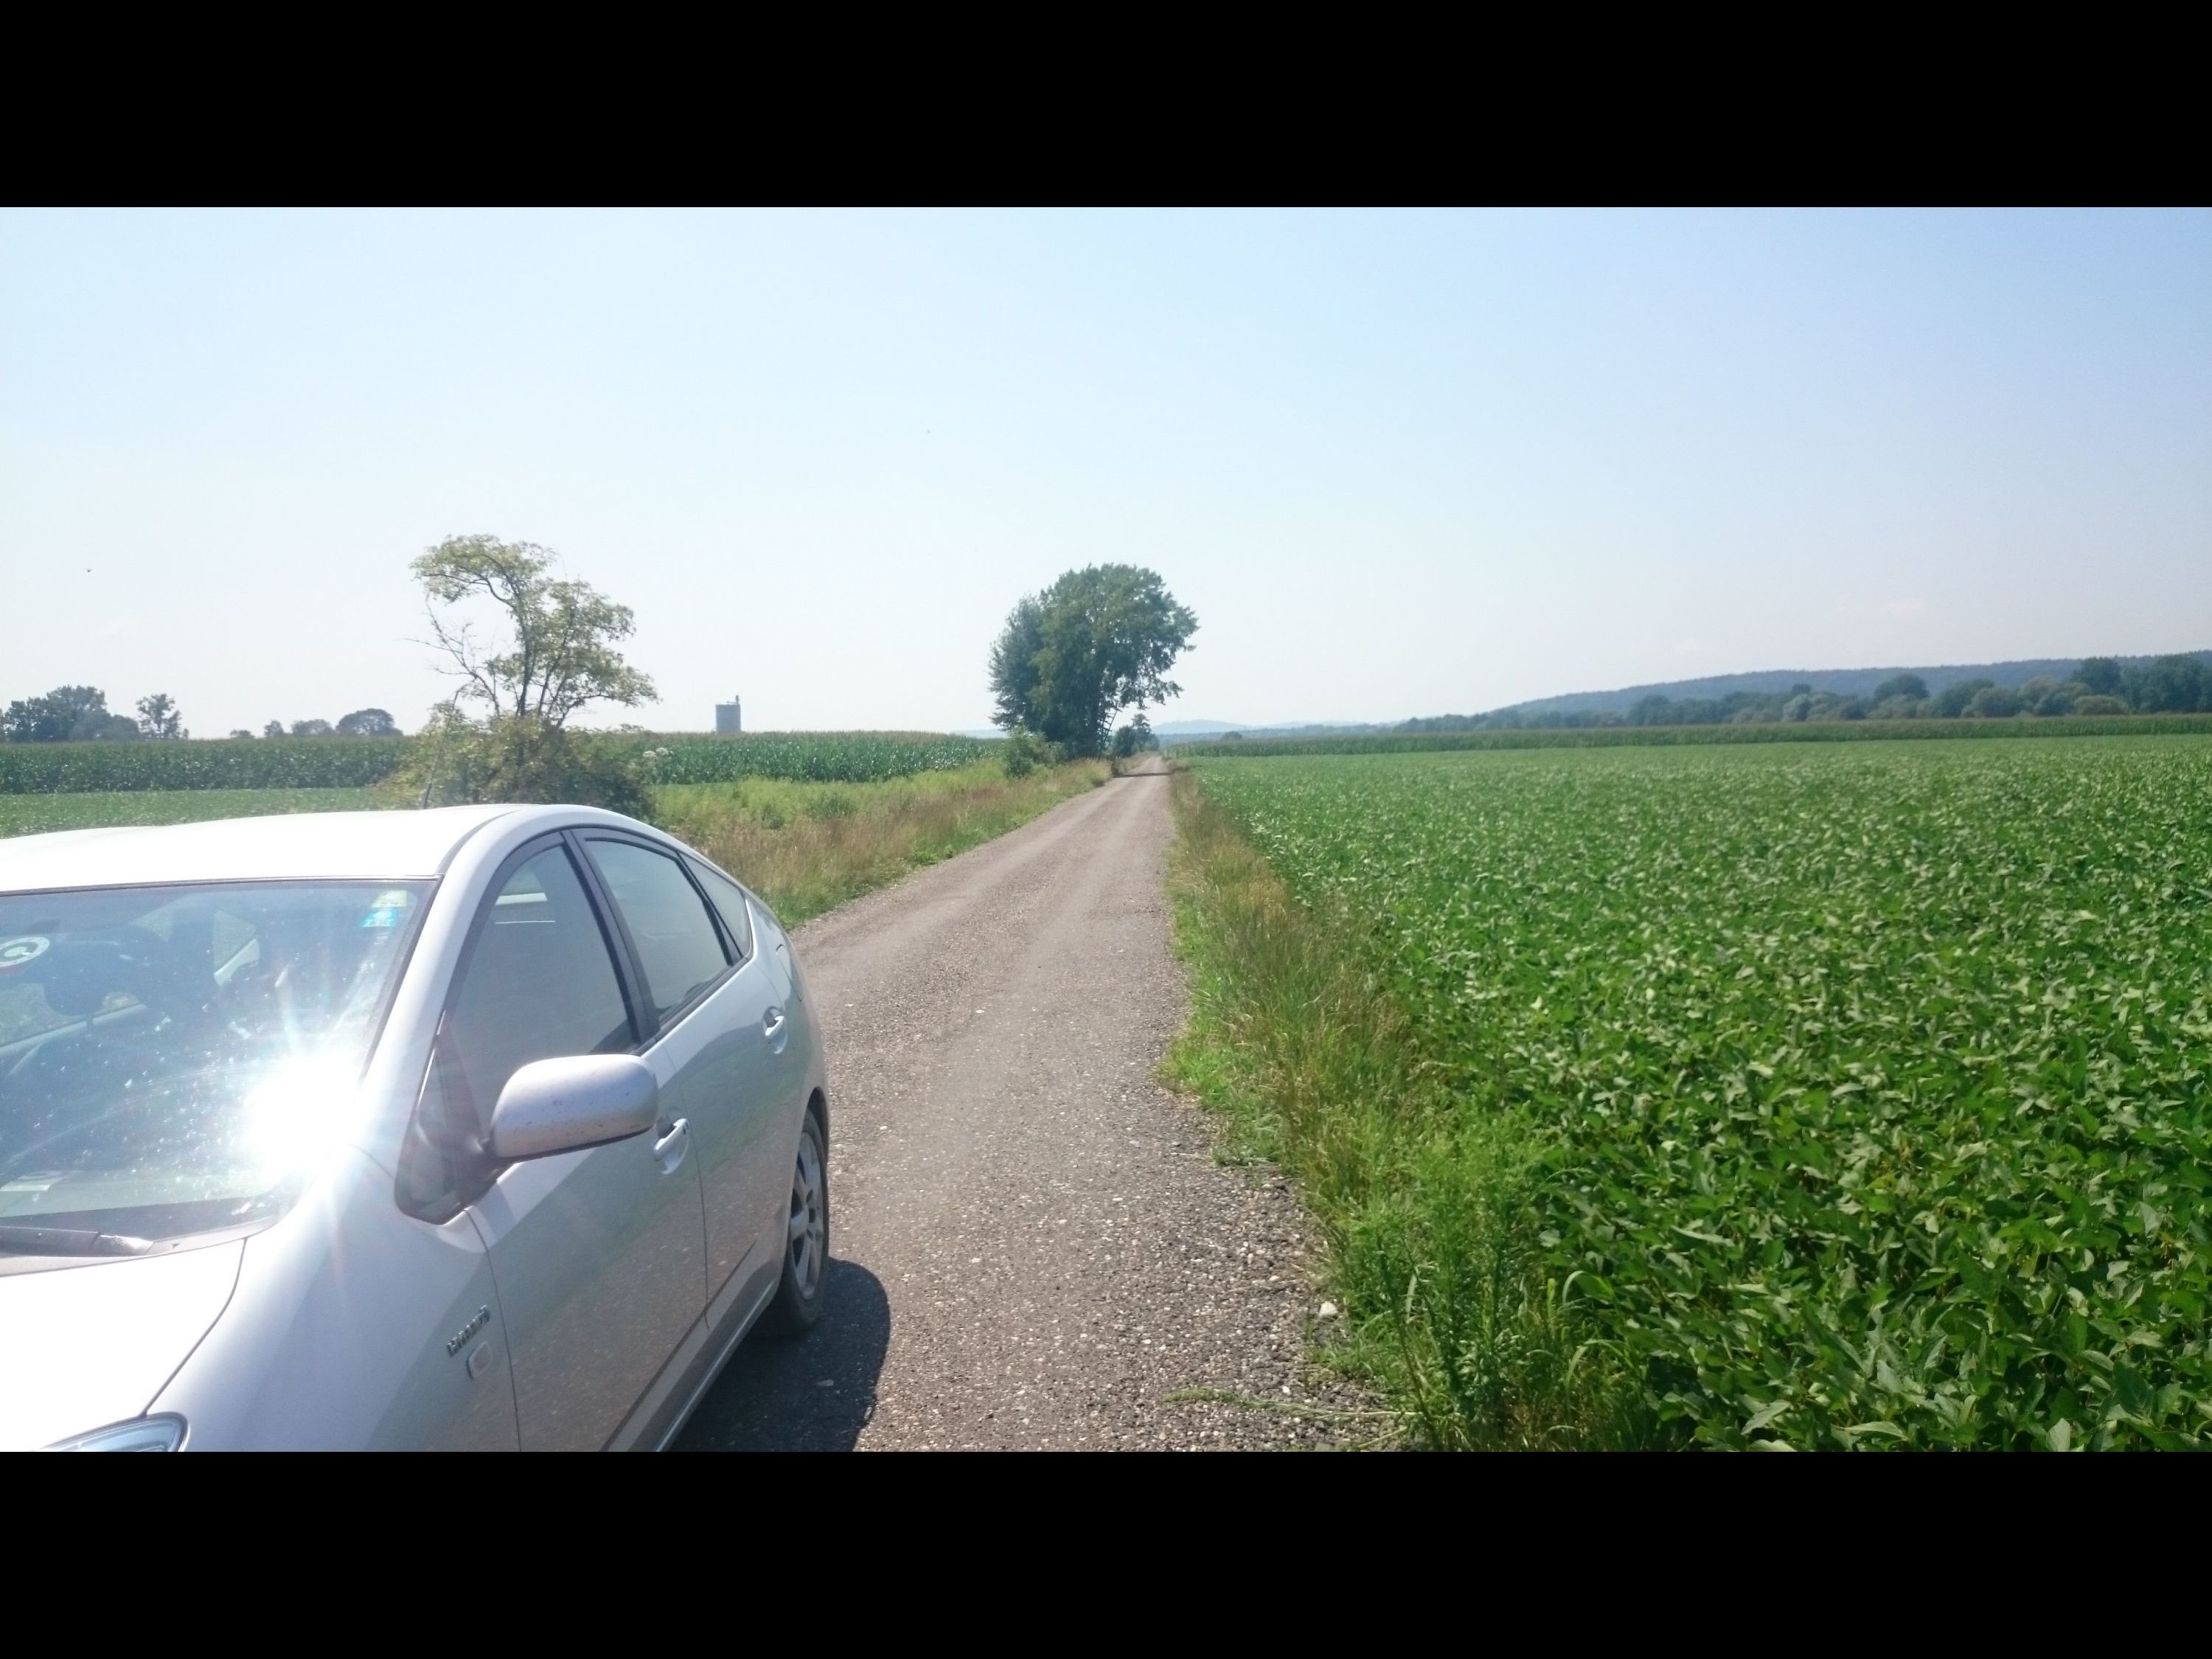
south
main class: Cropland
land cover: Soya
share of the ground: > 75 %
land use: Agriculture (excluding fallow land and kitchen gardens)
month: July
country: AT
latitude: 47.0979
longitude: 16.1016
